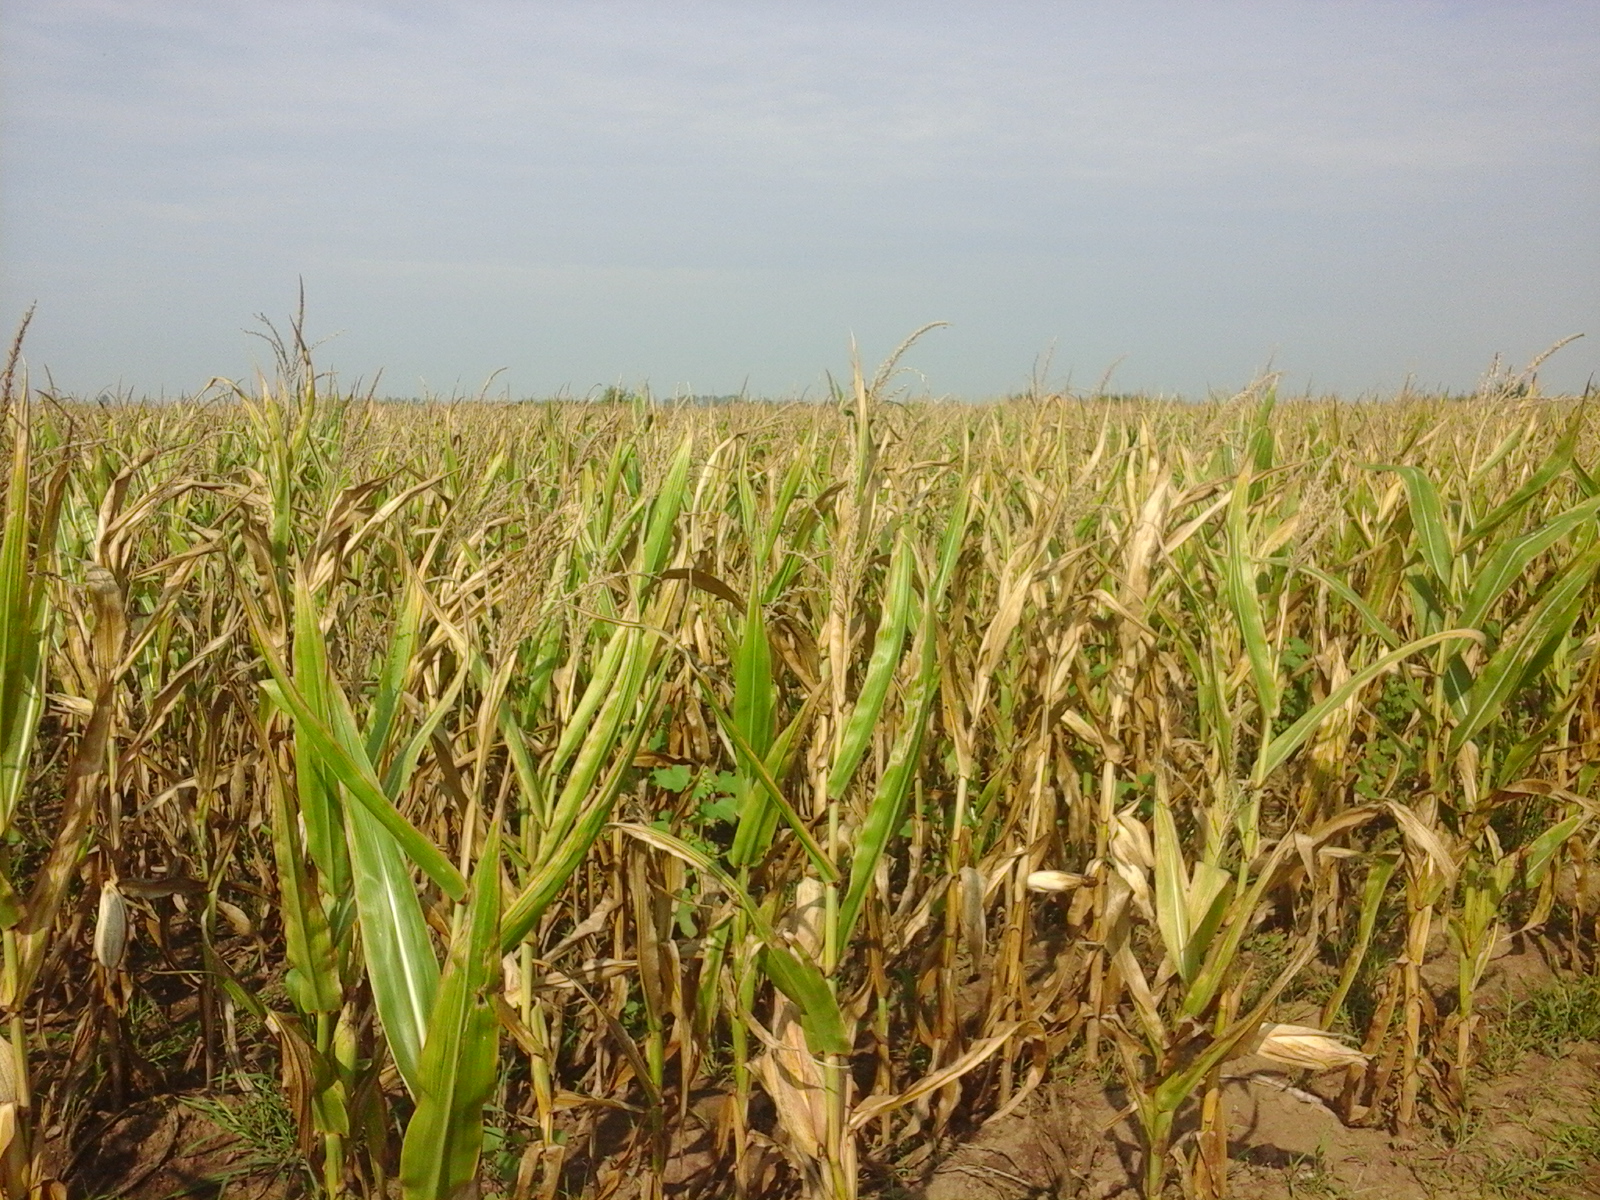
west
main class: Cropland
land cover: Maize
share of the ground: > 75 %
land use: Agriculture (excluding fallow land and kitchen gardens)
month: August
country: RO
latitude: 46.5413
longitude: 21.5531
